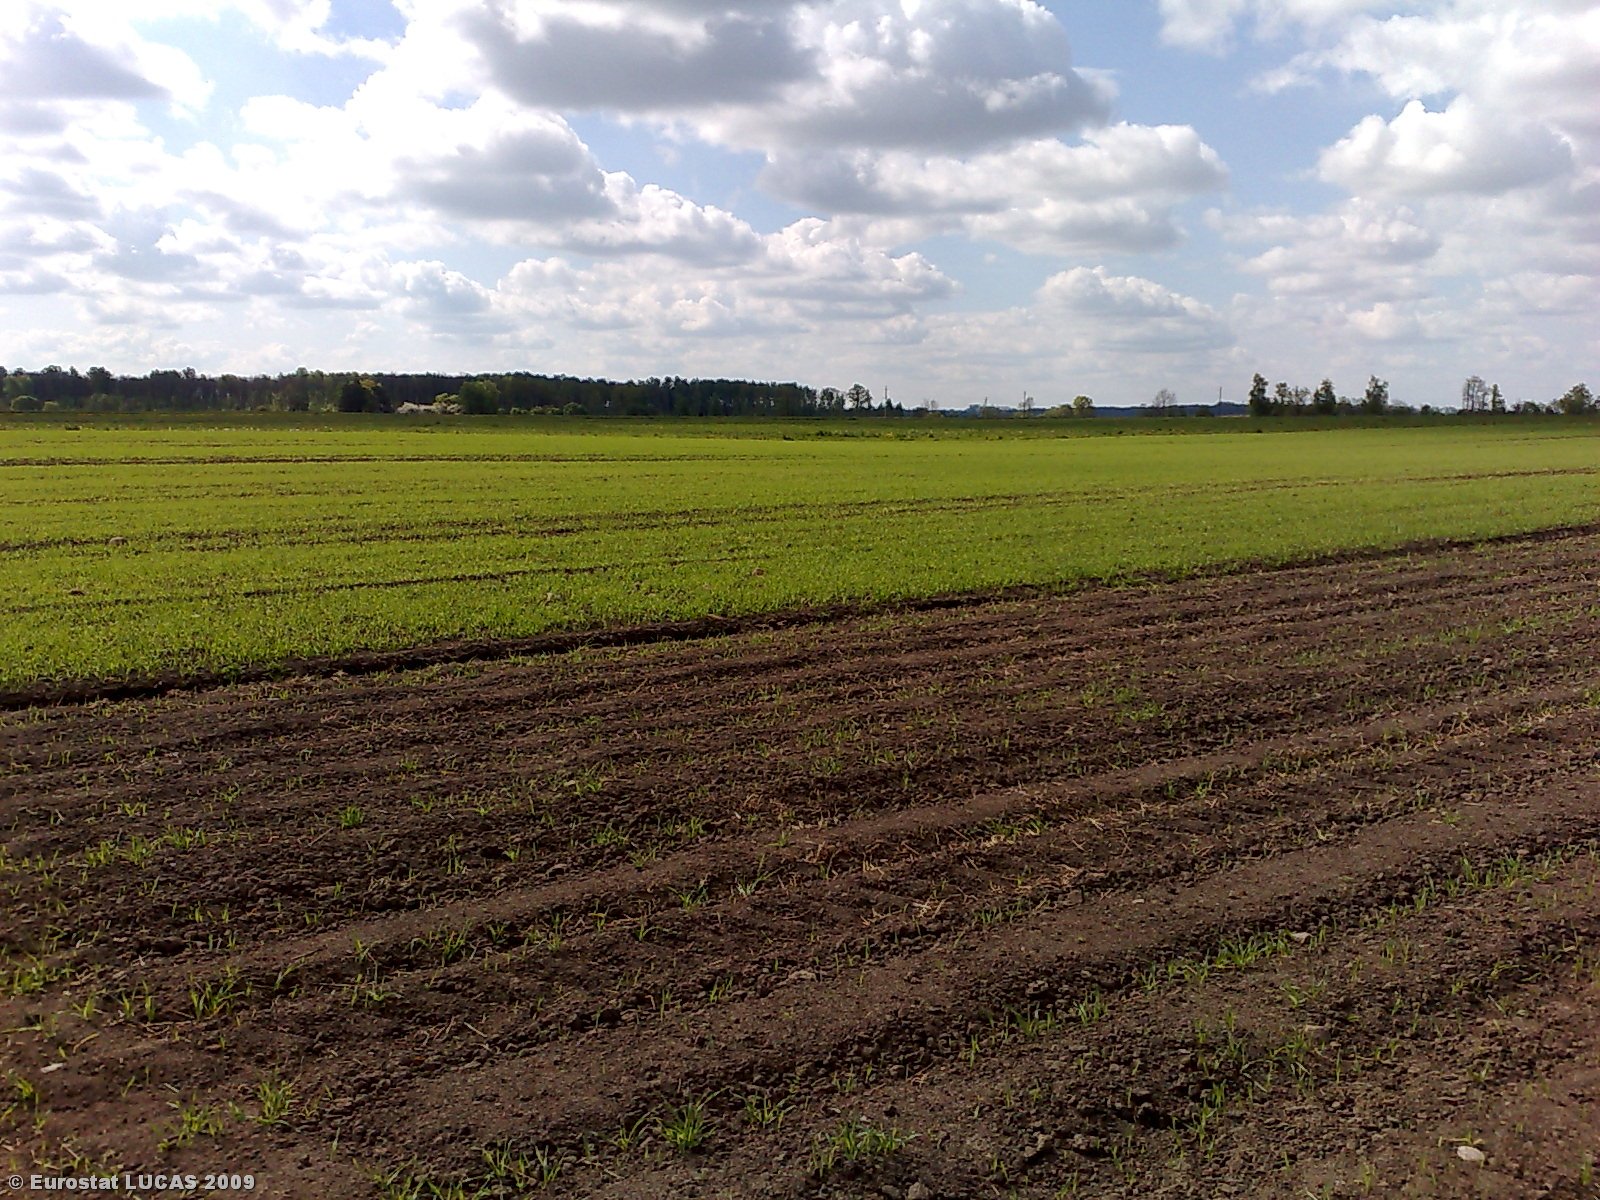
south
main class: Cropland
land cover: Barley
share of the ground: 25 - 50 %
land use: Agriculture (excluding fallow land and kitchen gardens)
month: May
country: LT
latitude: 55.6953
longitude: 23.9446
